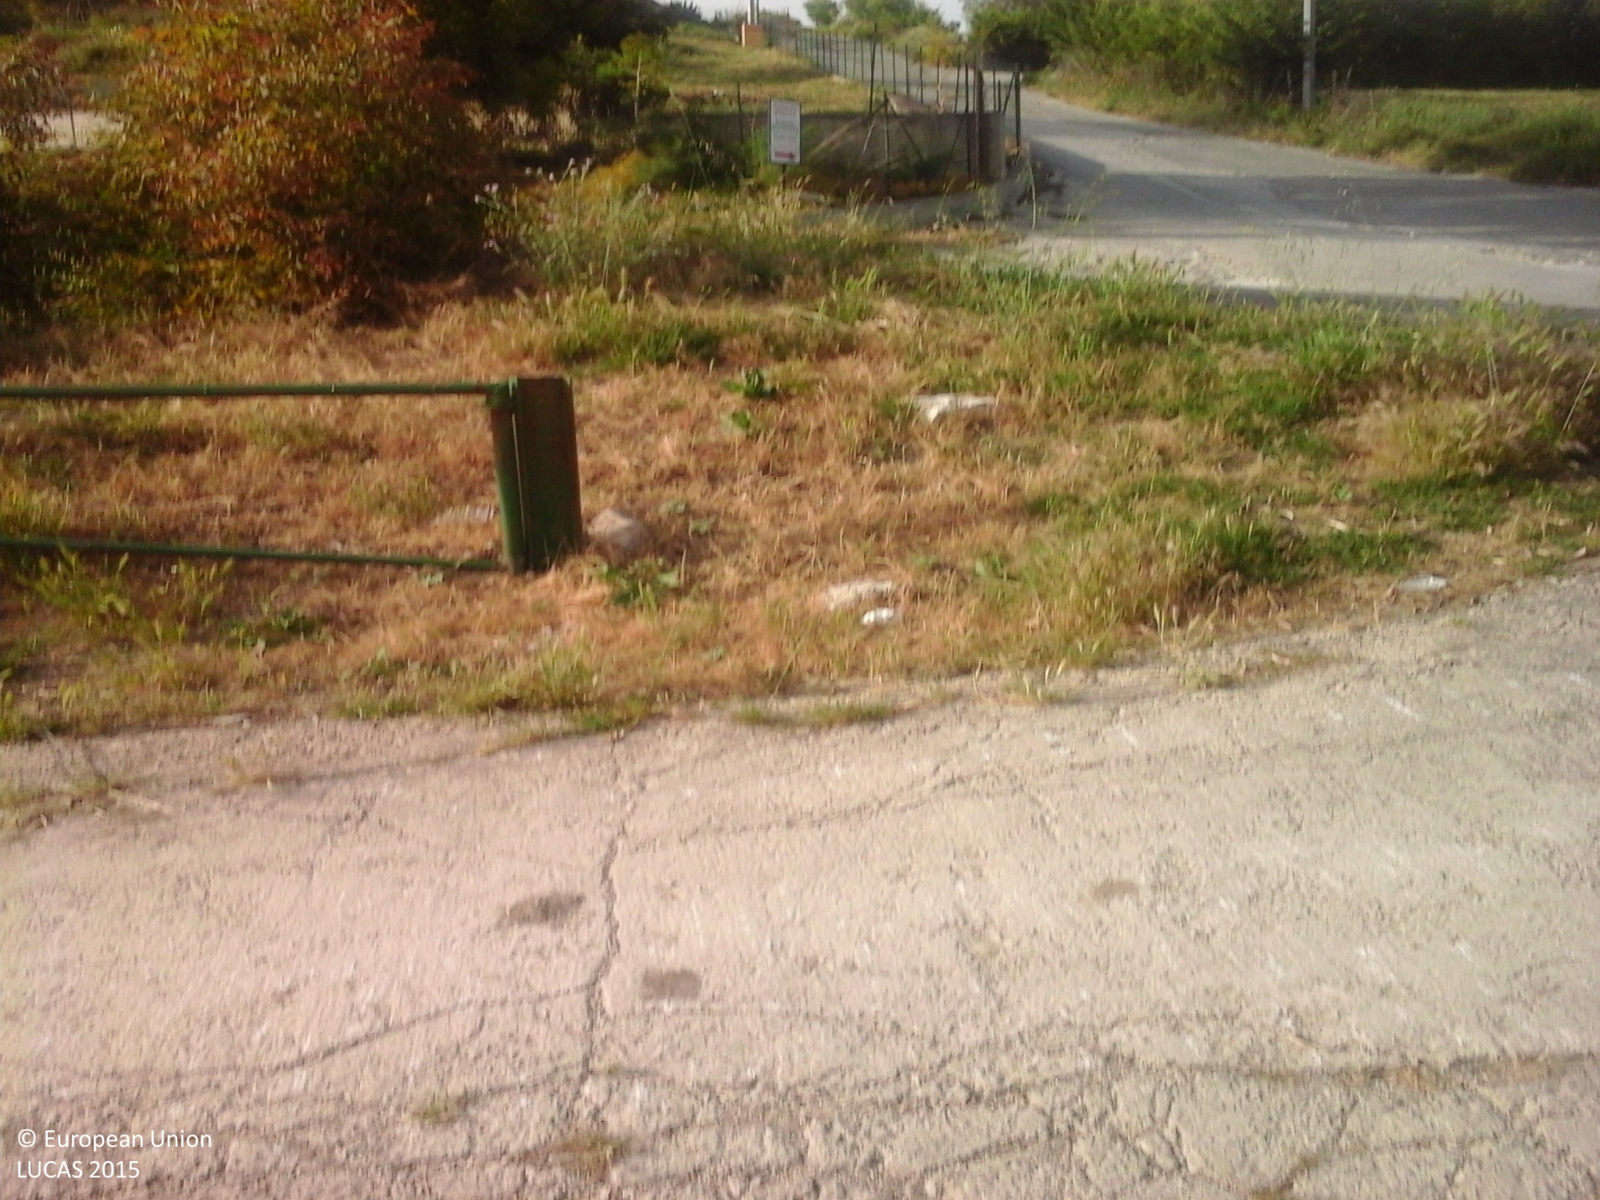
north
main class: Cropland
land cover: Durum wheat
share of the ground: > 75 %
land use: Agriculture (excluding fallow land and kitchen gardens)
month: May
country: IT
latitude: 37.6219
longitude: 13.6776
